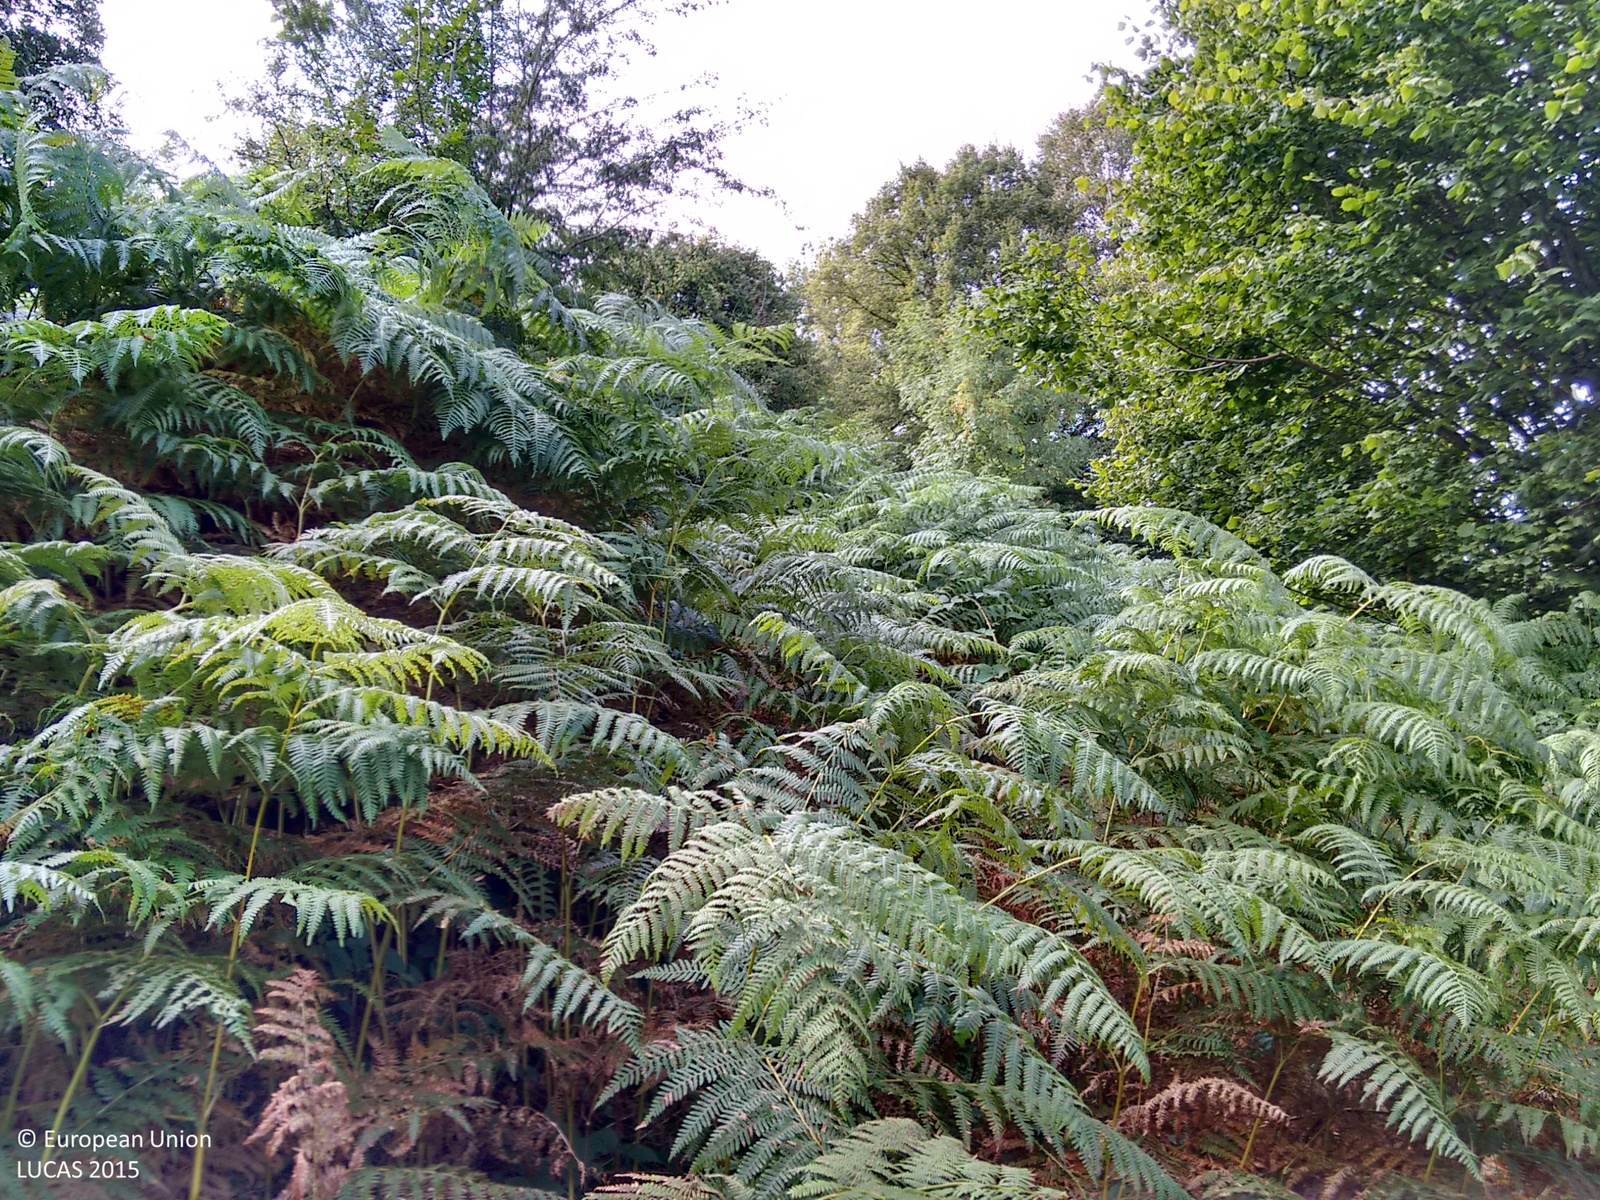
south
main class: Grassland
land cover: Grassland with sparse tree/shrub cover
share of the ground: > 75 %
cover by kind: herbaceous plants 95 %, broadleaved forest trees 5 %
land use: Semi-natural and natural areas not in use
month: September
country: GB
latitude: 51.8160
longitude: -3.0593
